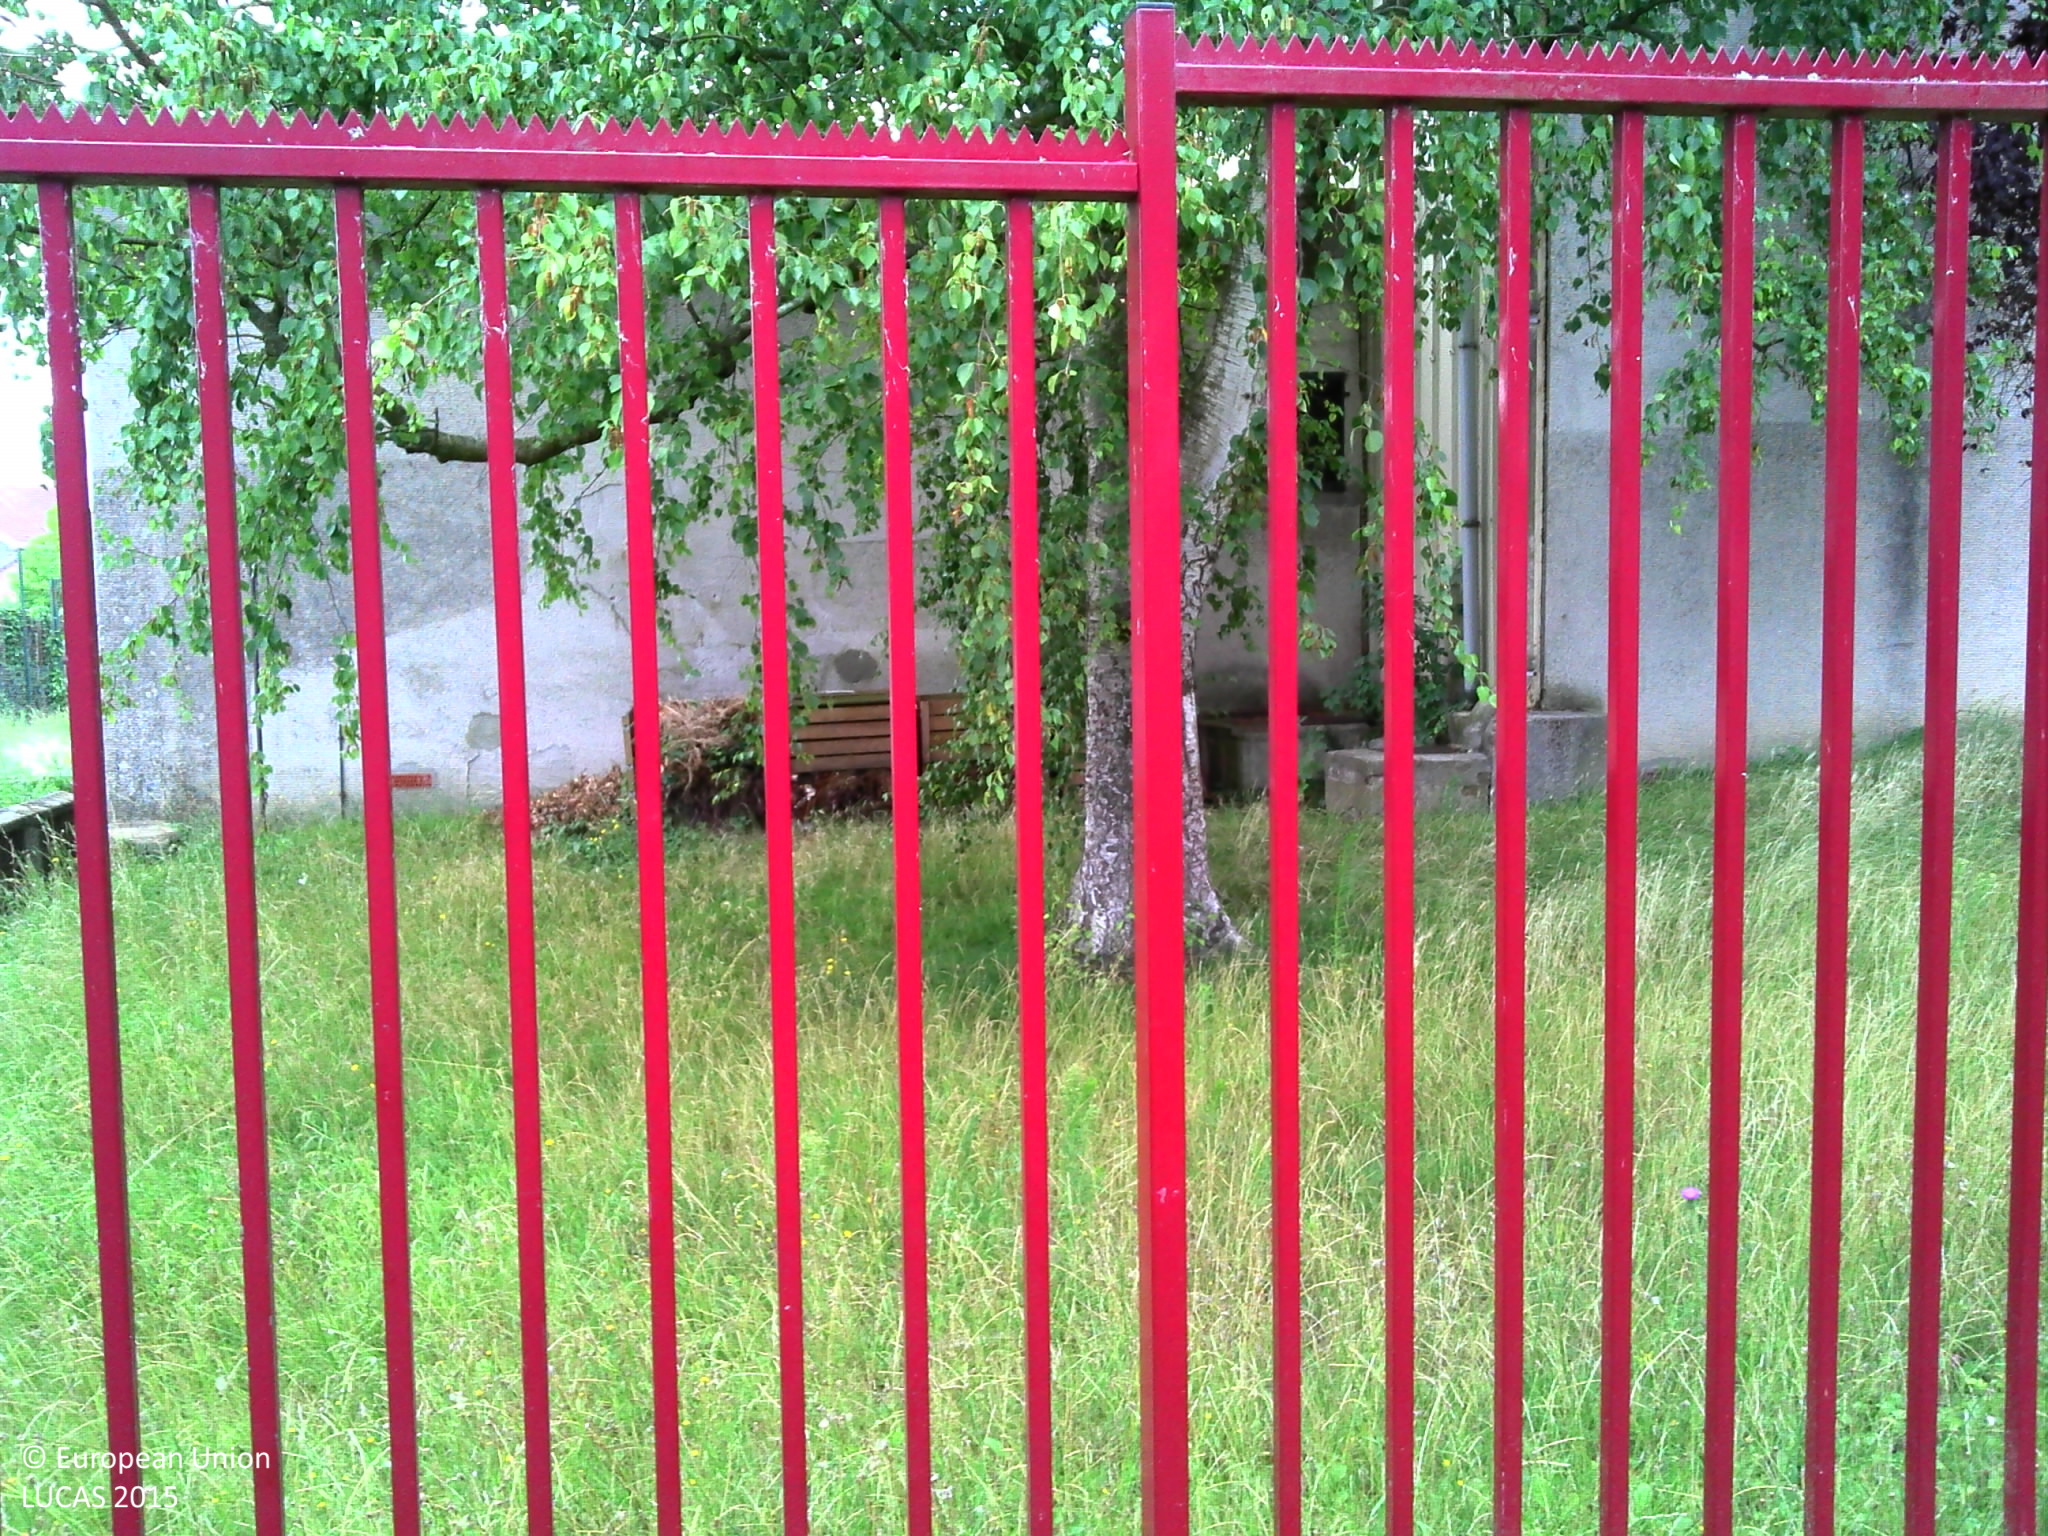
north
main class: Grassland
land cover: Grassland without tree/shrub cover
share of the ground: > 75 %
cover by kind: herbaceous plants 100 %
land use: Community services
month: July
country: FR
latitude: 50.4545
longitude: 3.5841
